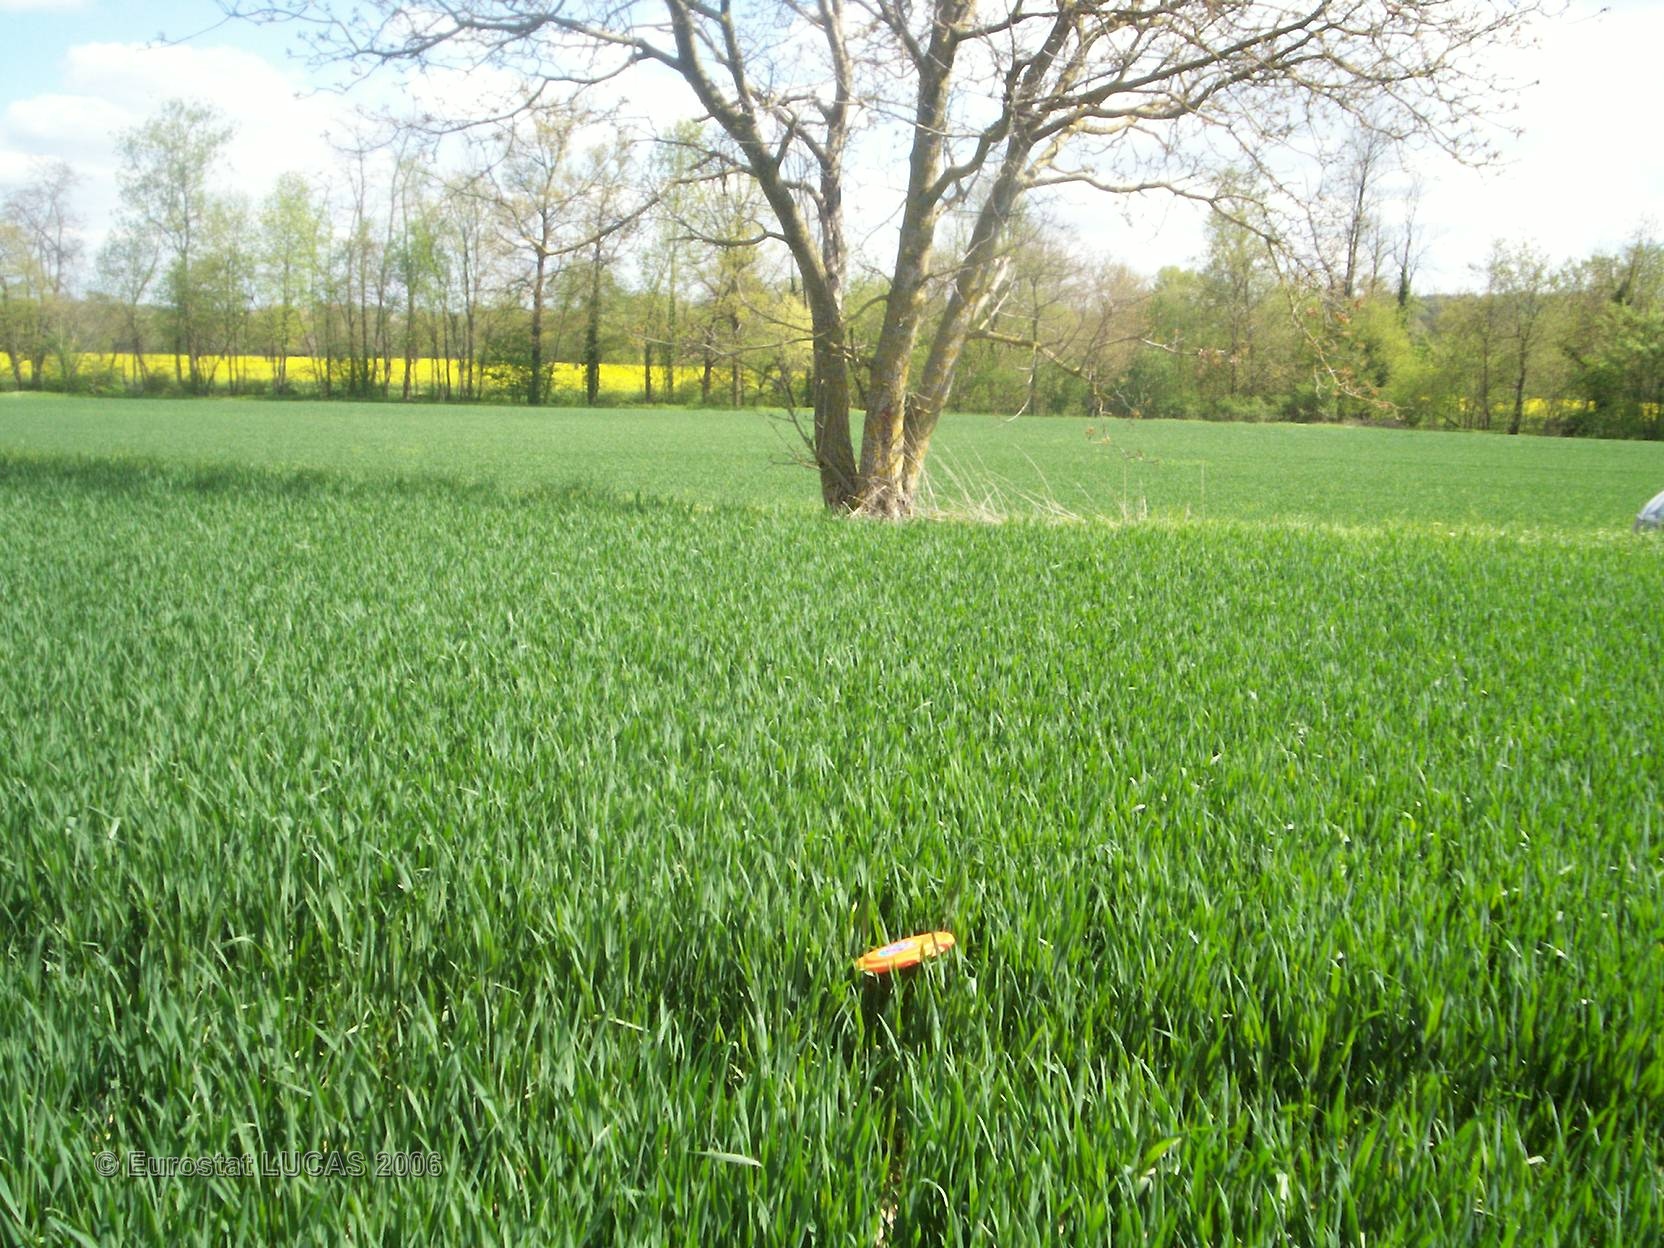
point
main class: Cropland
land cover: Common wheat
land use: Agriculture (excluding fallow land and kitchen gardens)
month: April
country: FR
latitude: 46.2621
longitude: 3.2133
